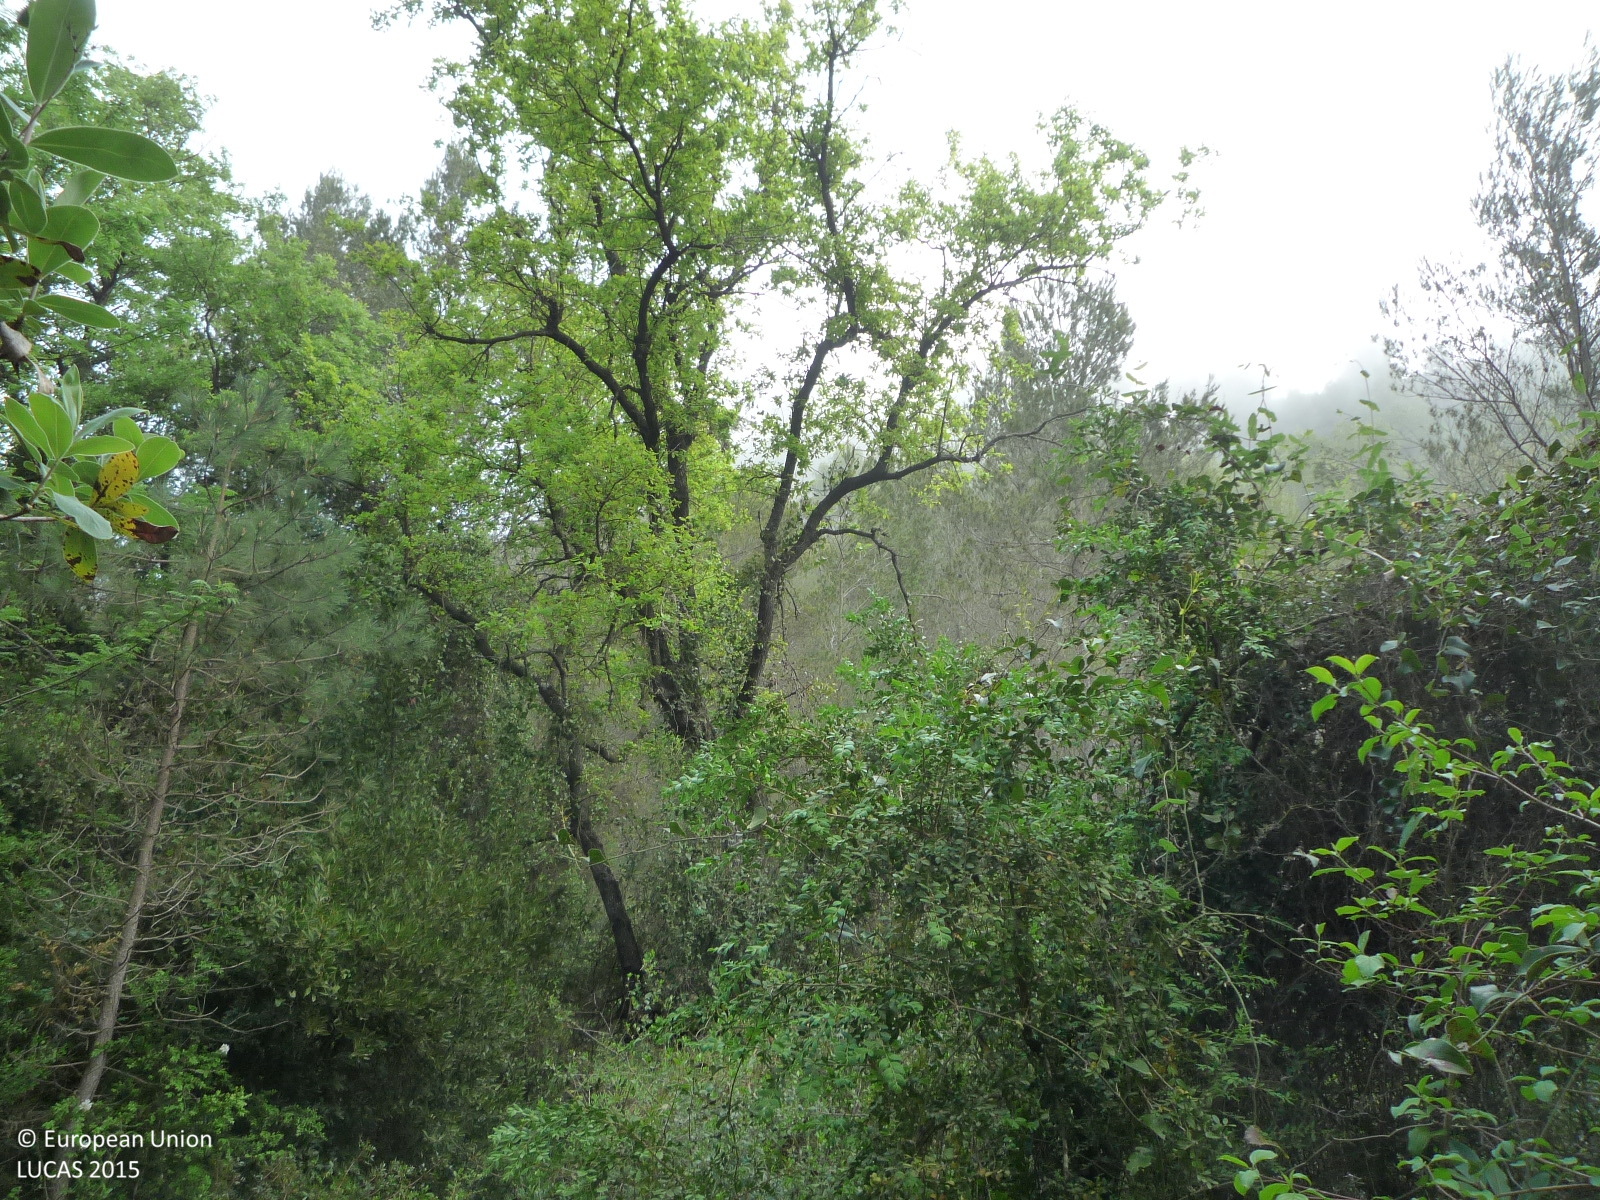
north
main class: Woodland
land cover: Pine dominated mixed woodland
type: coniferous forest of the mediterranean region
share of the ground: > 75 %
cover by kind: coniferous forest trees 60 %, broadleaved forest trees 40 %
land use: Semi-natural and natural areas not in use
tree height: > 5 m
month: April
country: ES
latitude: 41.6768
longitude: 1.6907
